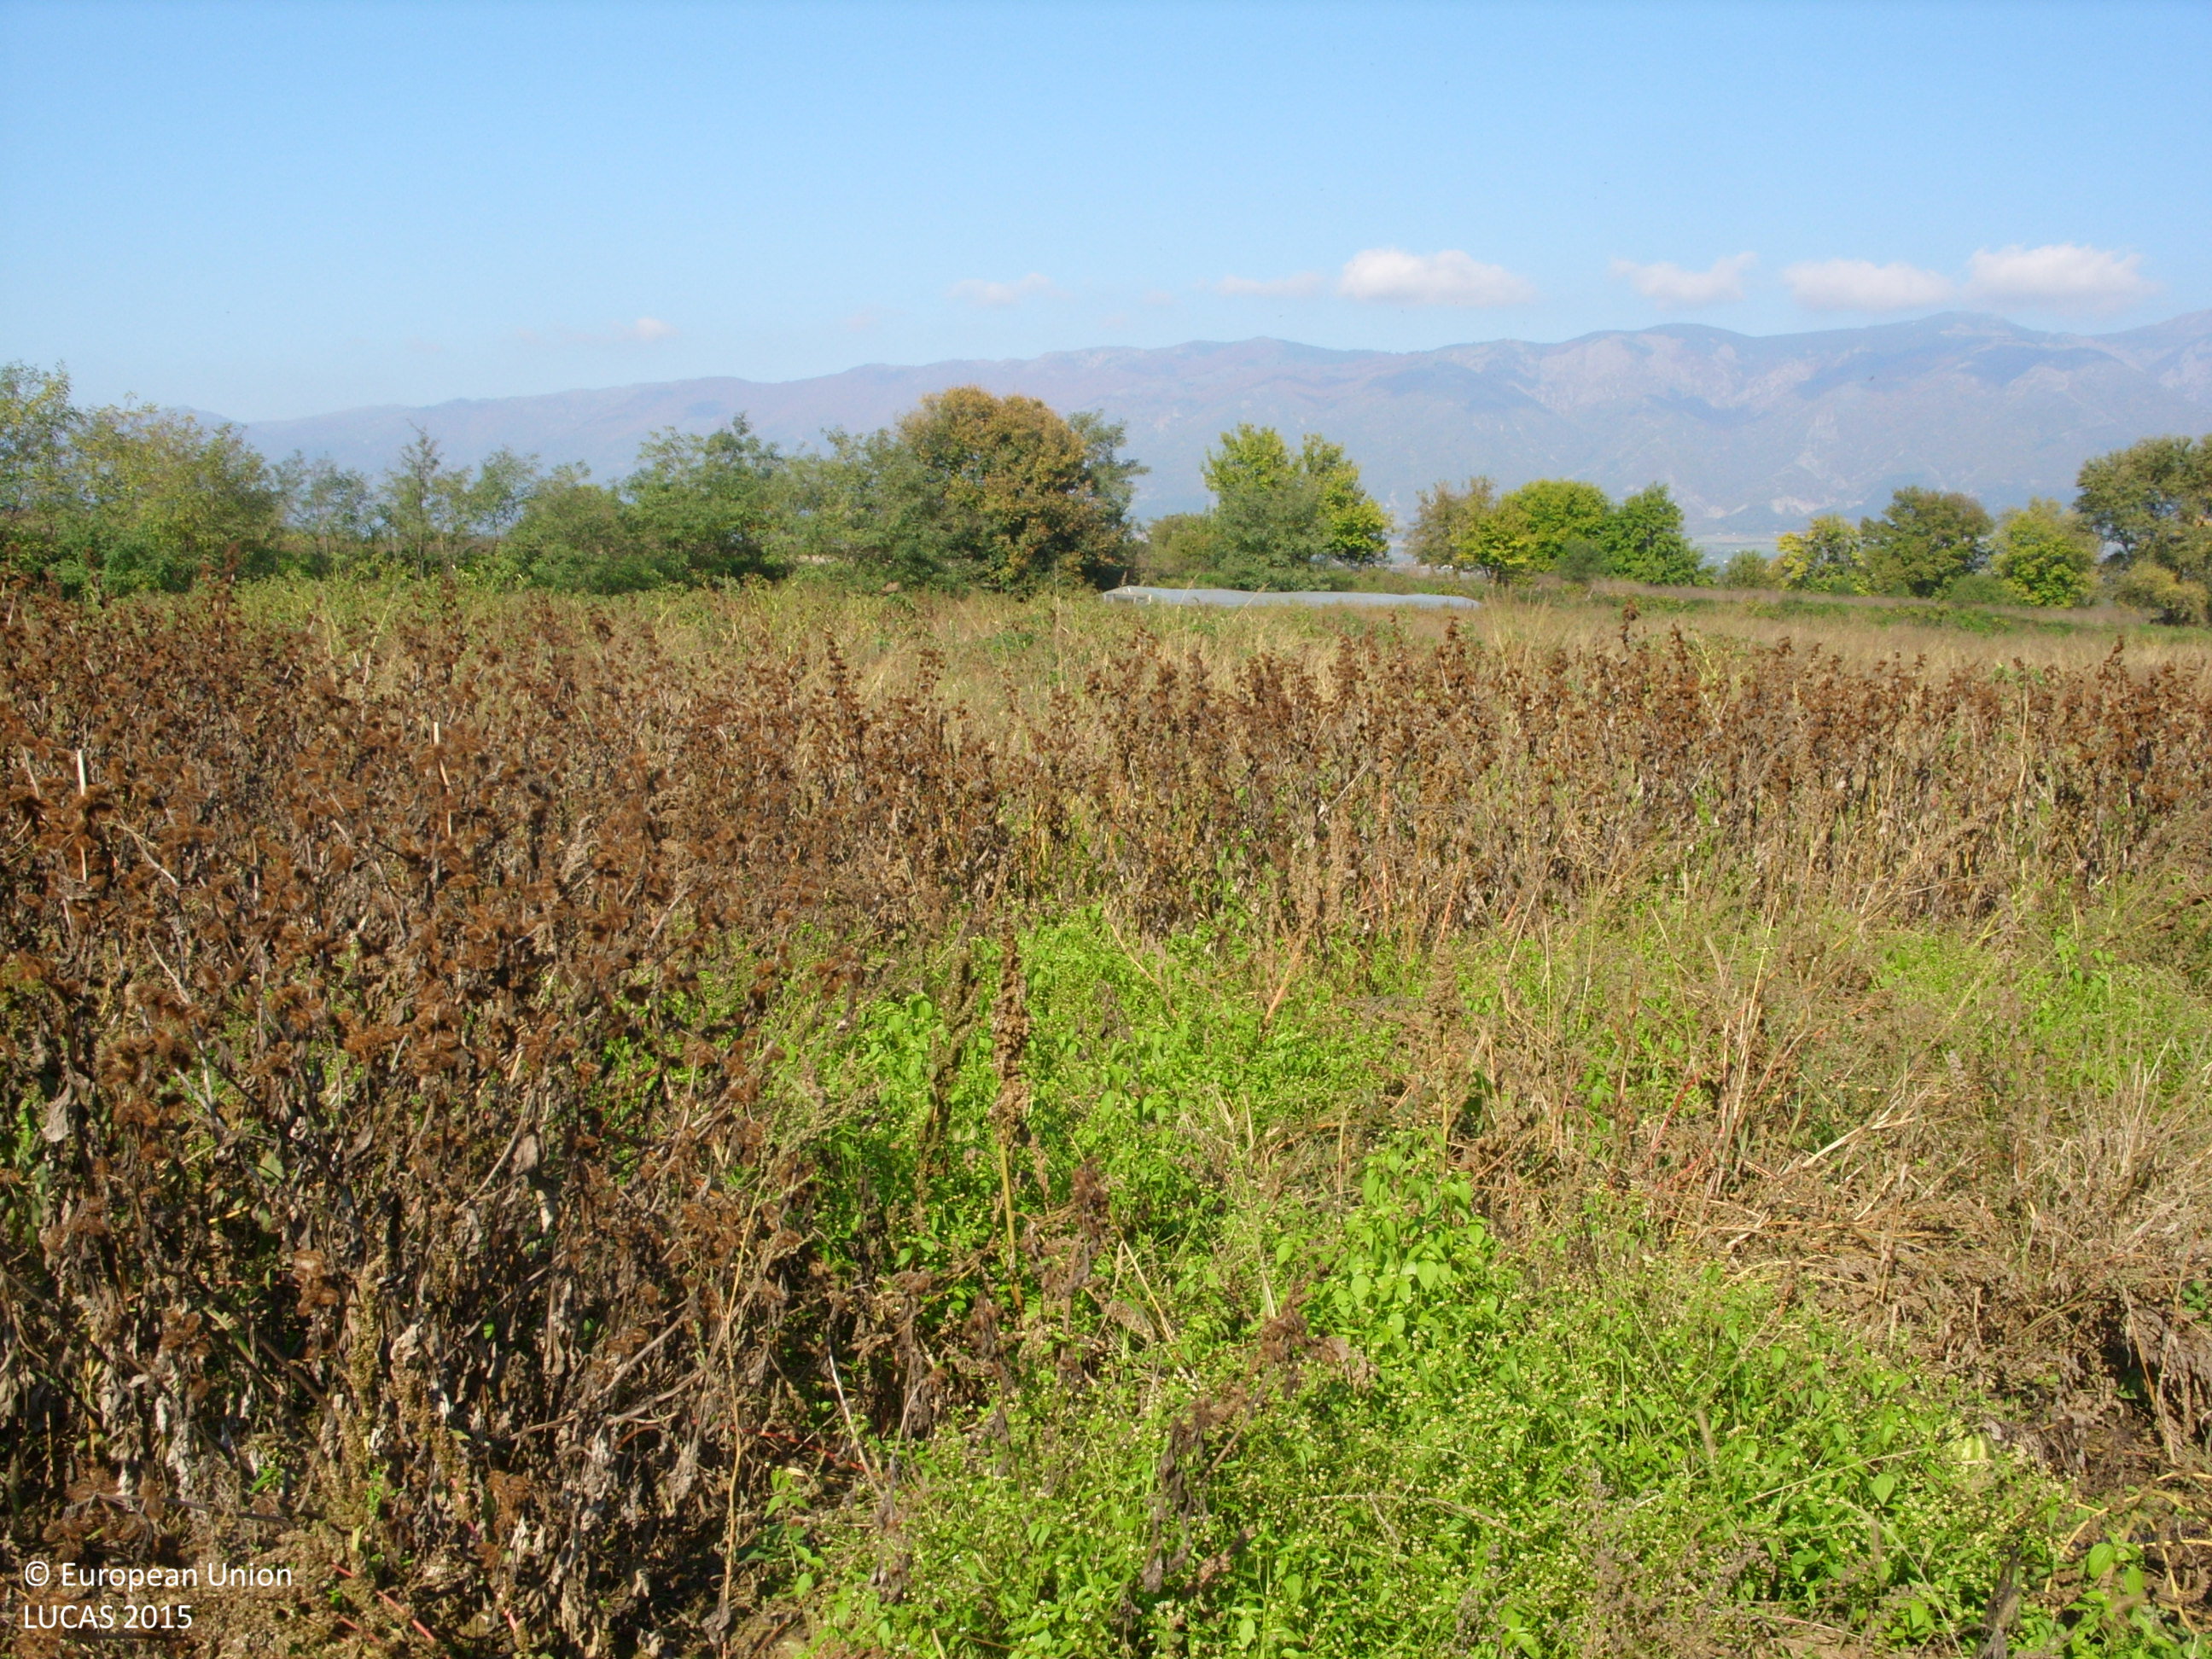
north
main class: Cropland
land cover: Other fresh vegetables
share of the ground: 25 - 50 %
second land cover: Spontaneously vegetated surfaces
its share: 50 - 75 %
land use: Agriculture (excluding fallow land and kitchen gardens)
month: October
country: BG
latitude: 42.6018
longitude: 24.6938
